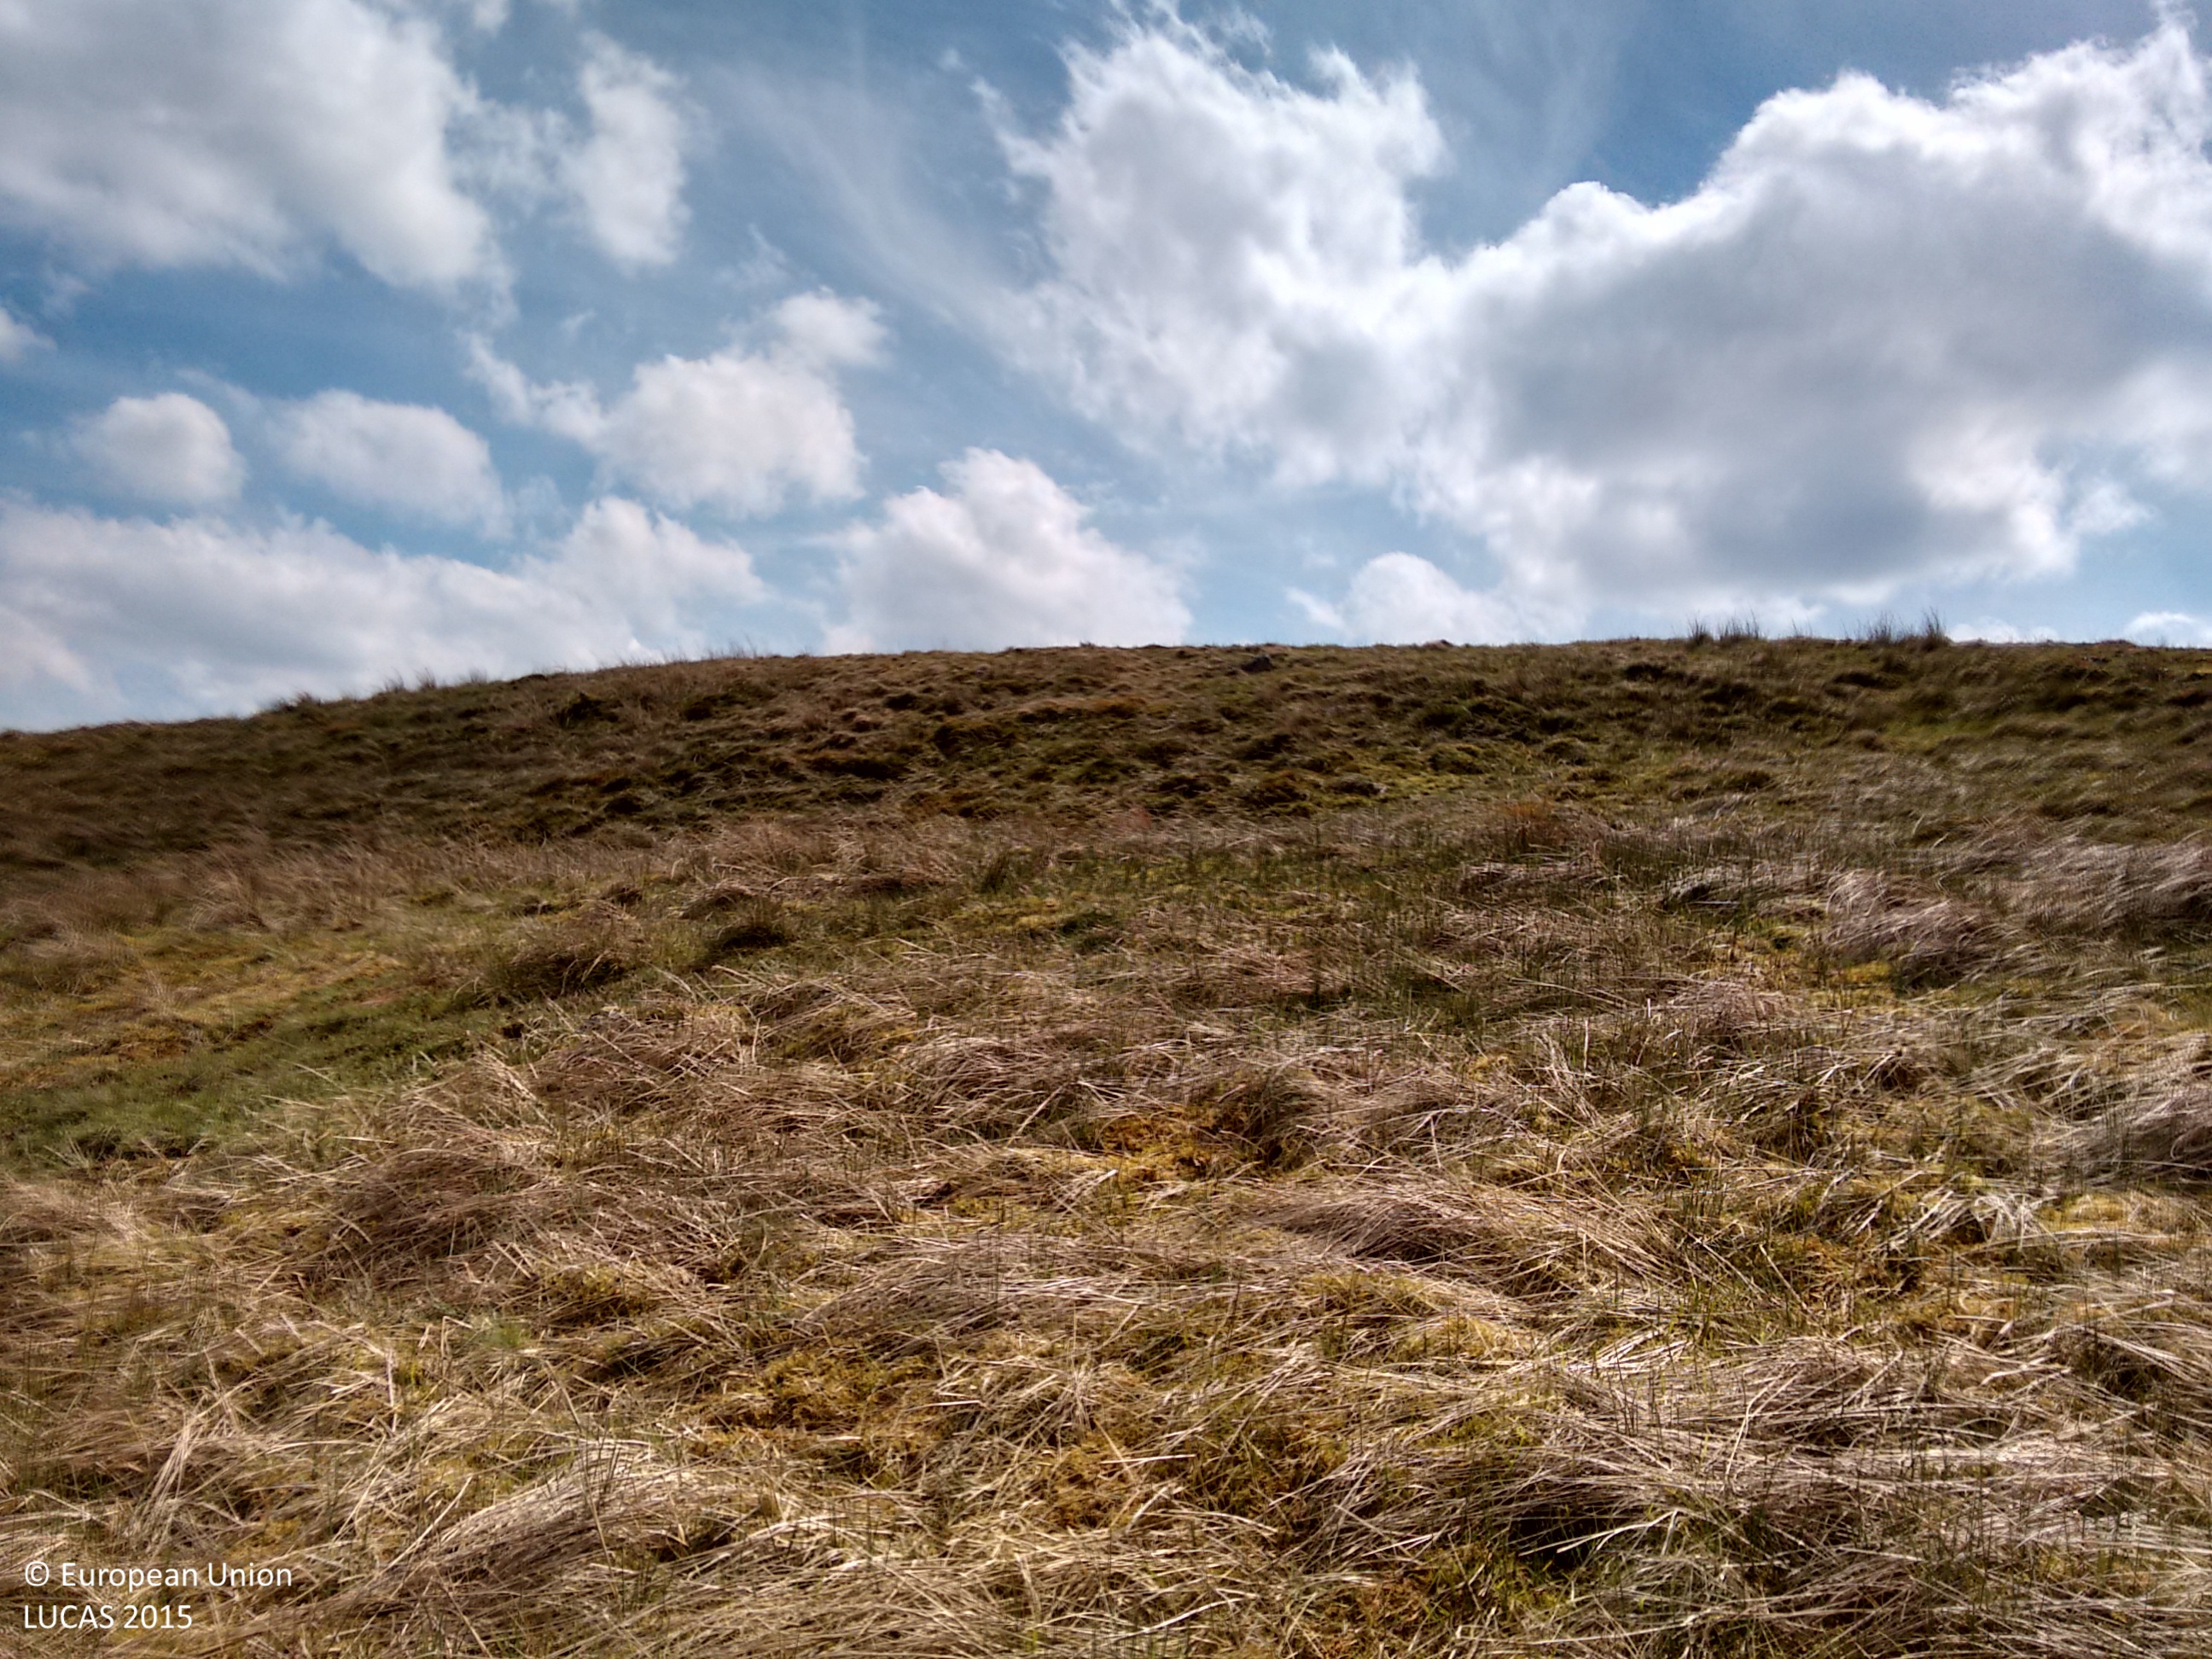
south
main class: Grassland
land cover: Grassland without tree/shrub cover
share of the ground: > 75 %
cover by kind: herbaceous plants 100 %
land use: Agriculture (excluding fallow land and kitchen gardens)
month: June
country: GB
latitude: 54.1822
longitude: -2.2106
